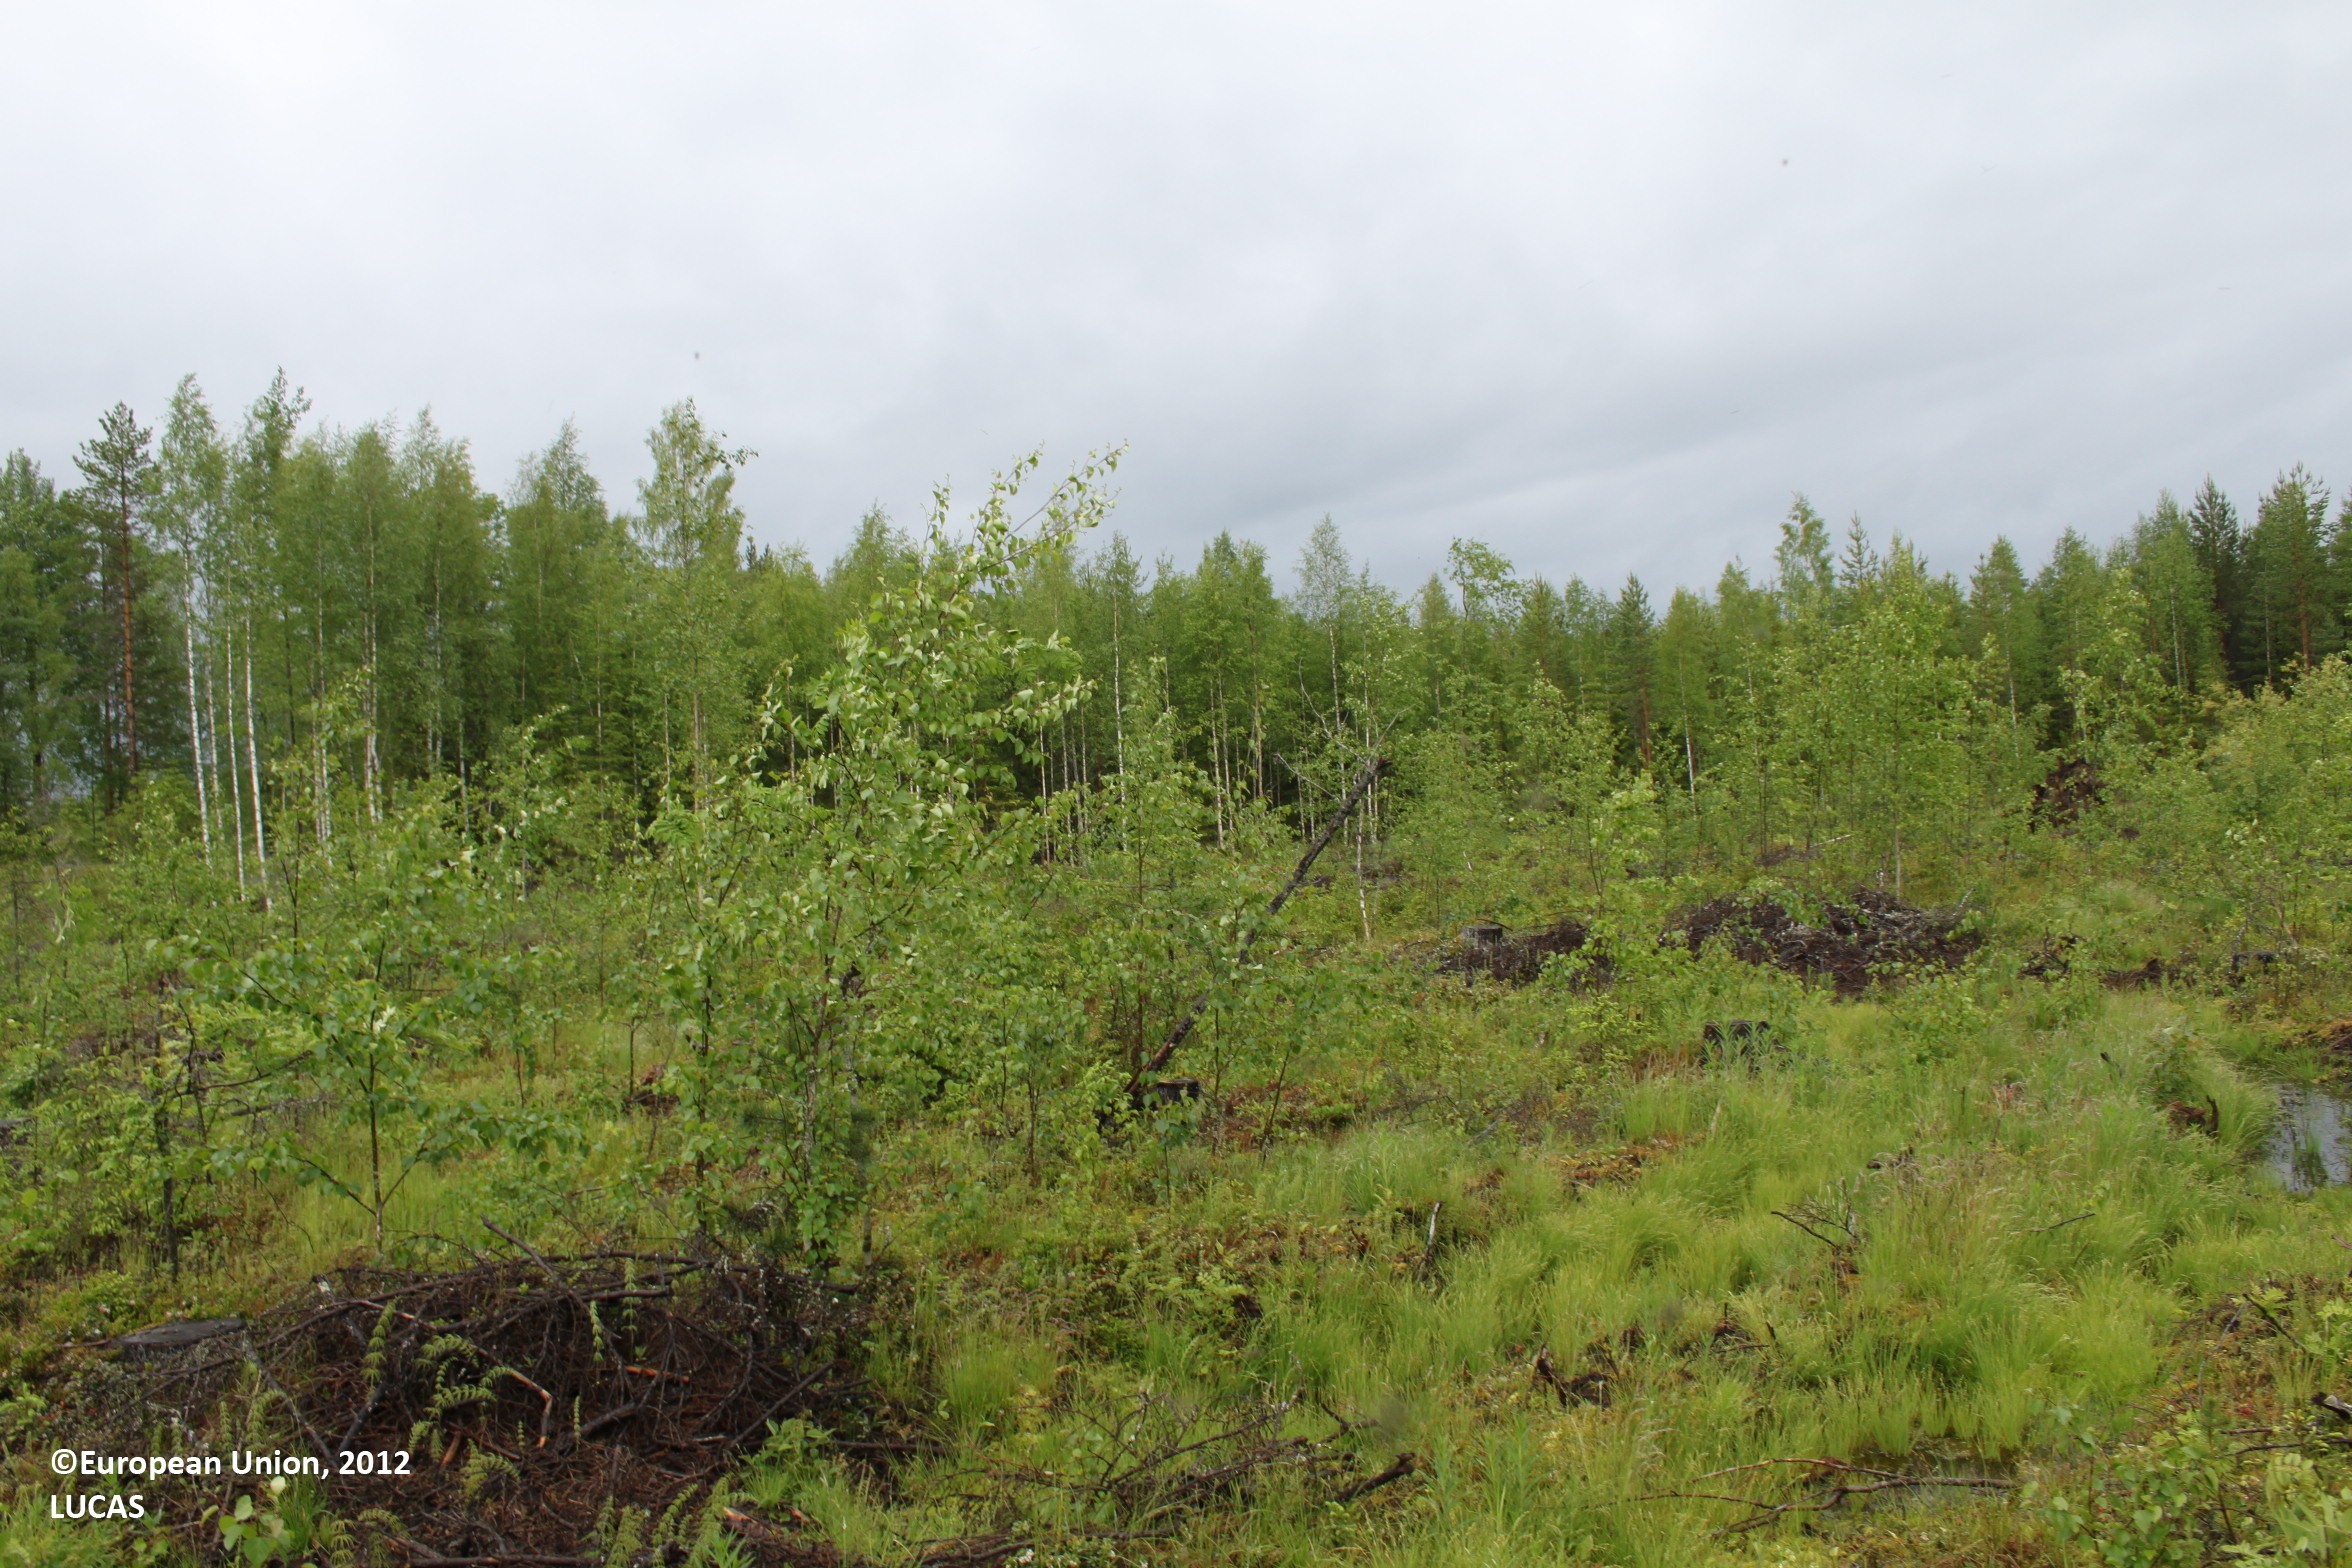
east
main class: Woodland
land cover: Broadleaved woodland
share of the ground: > 75 %
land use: Forestry
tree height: < 5 m
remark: Harvested field
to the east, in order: Broadleaved woodland; Dry stone walls; Spruce dominated coniferous woodland
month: June
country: FI
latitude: 61.8019
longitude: 28.3588
